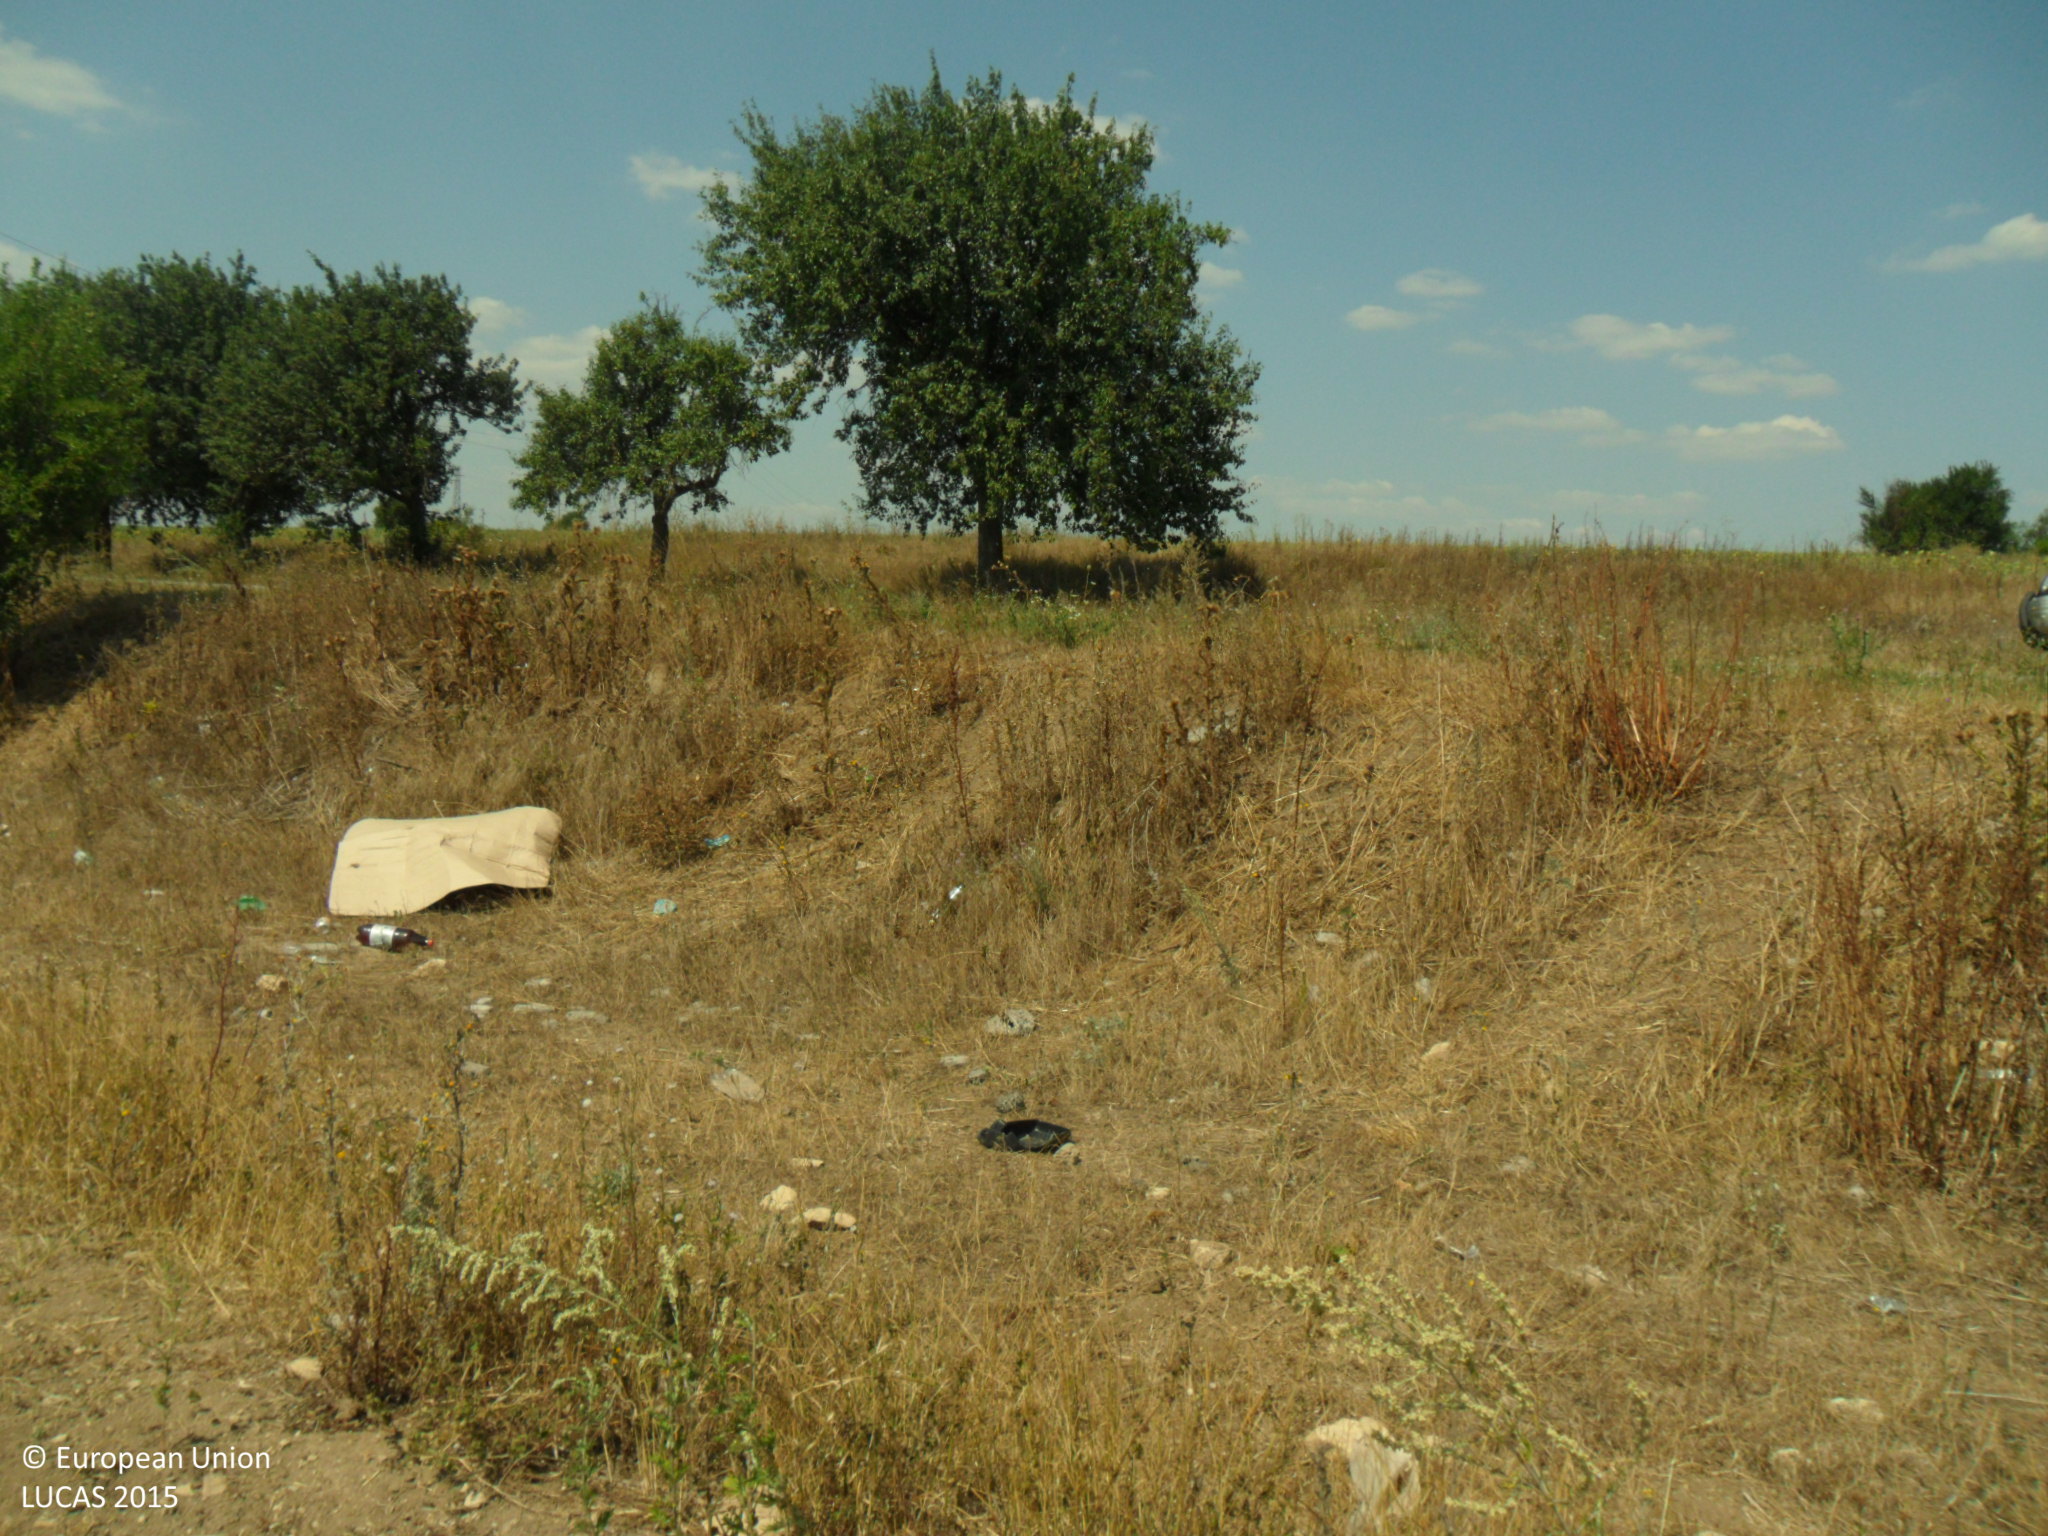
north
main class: Grassland
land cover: Grassland with sparse tree/shrub cover
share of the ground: > 75 %
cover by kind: herbaceous plants 90 %, broadleaved forest trees 5 %, shrubs 5 %
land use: Agriculture (excluding fallow land and kitchen gardens)
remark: Harvested field
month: August
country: BG
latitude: 43.5418
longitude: 27.1132
